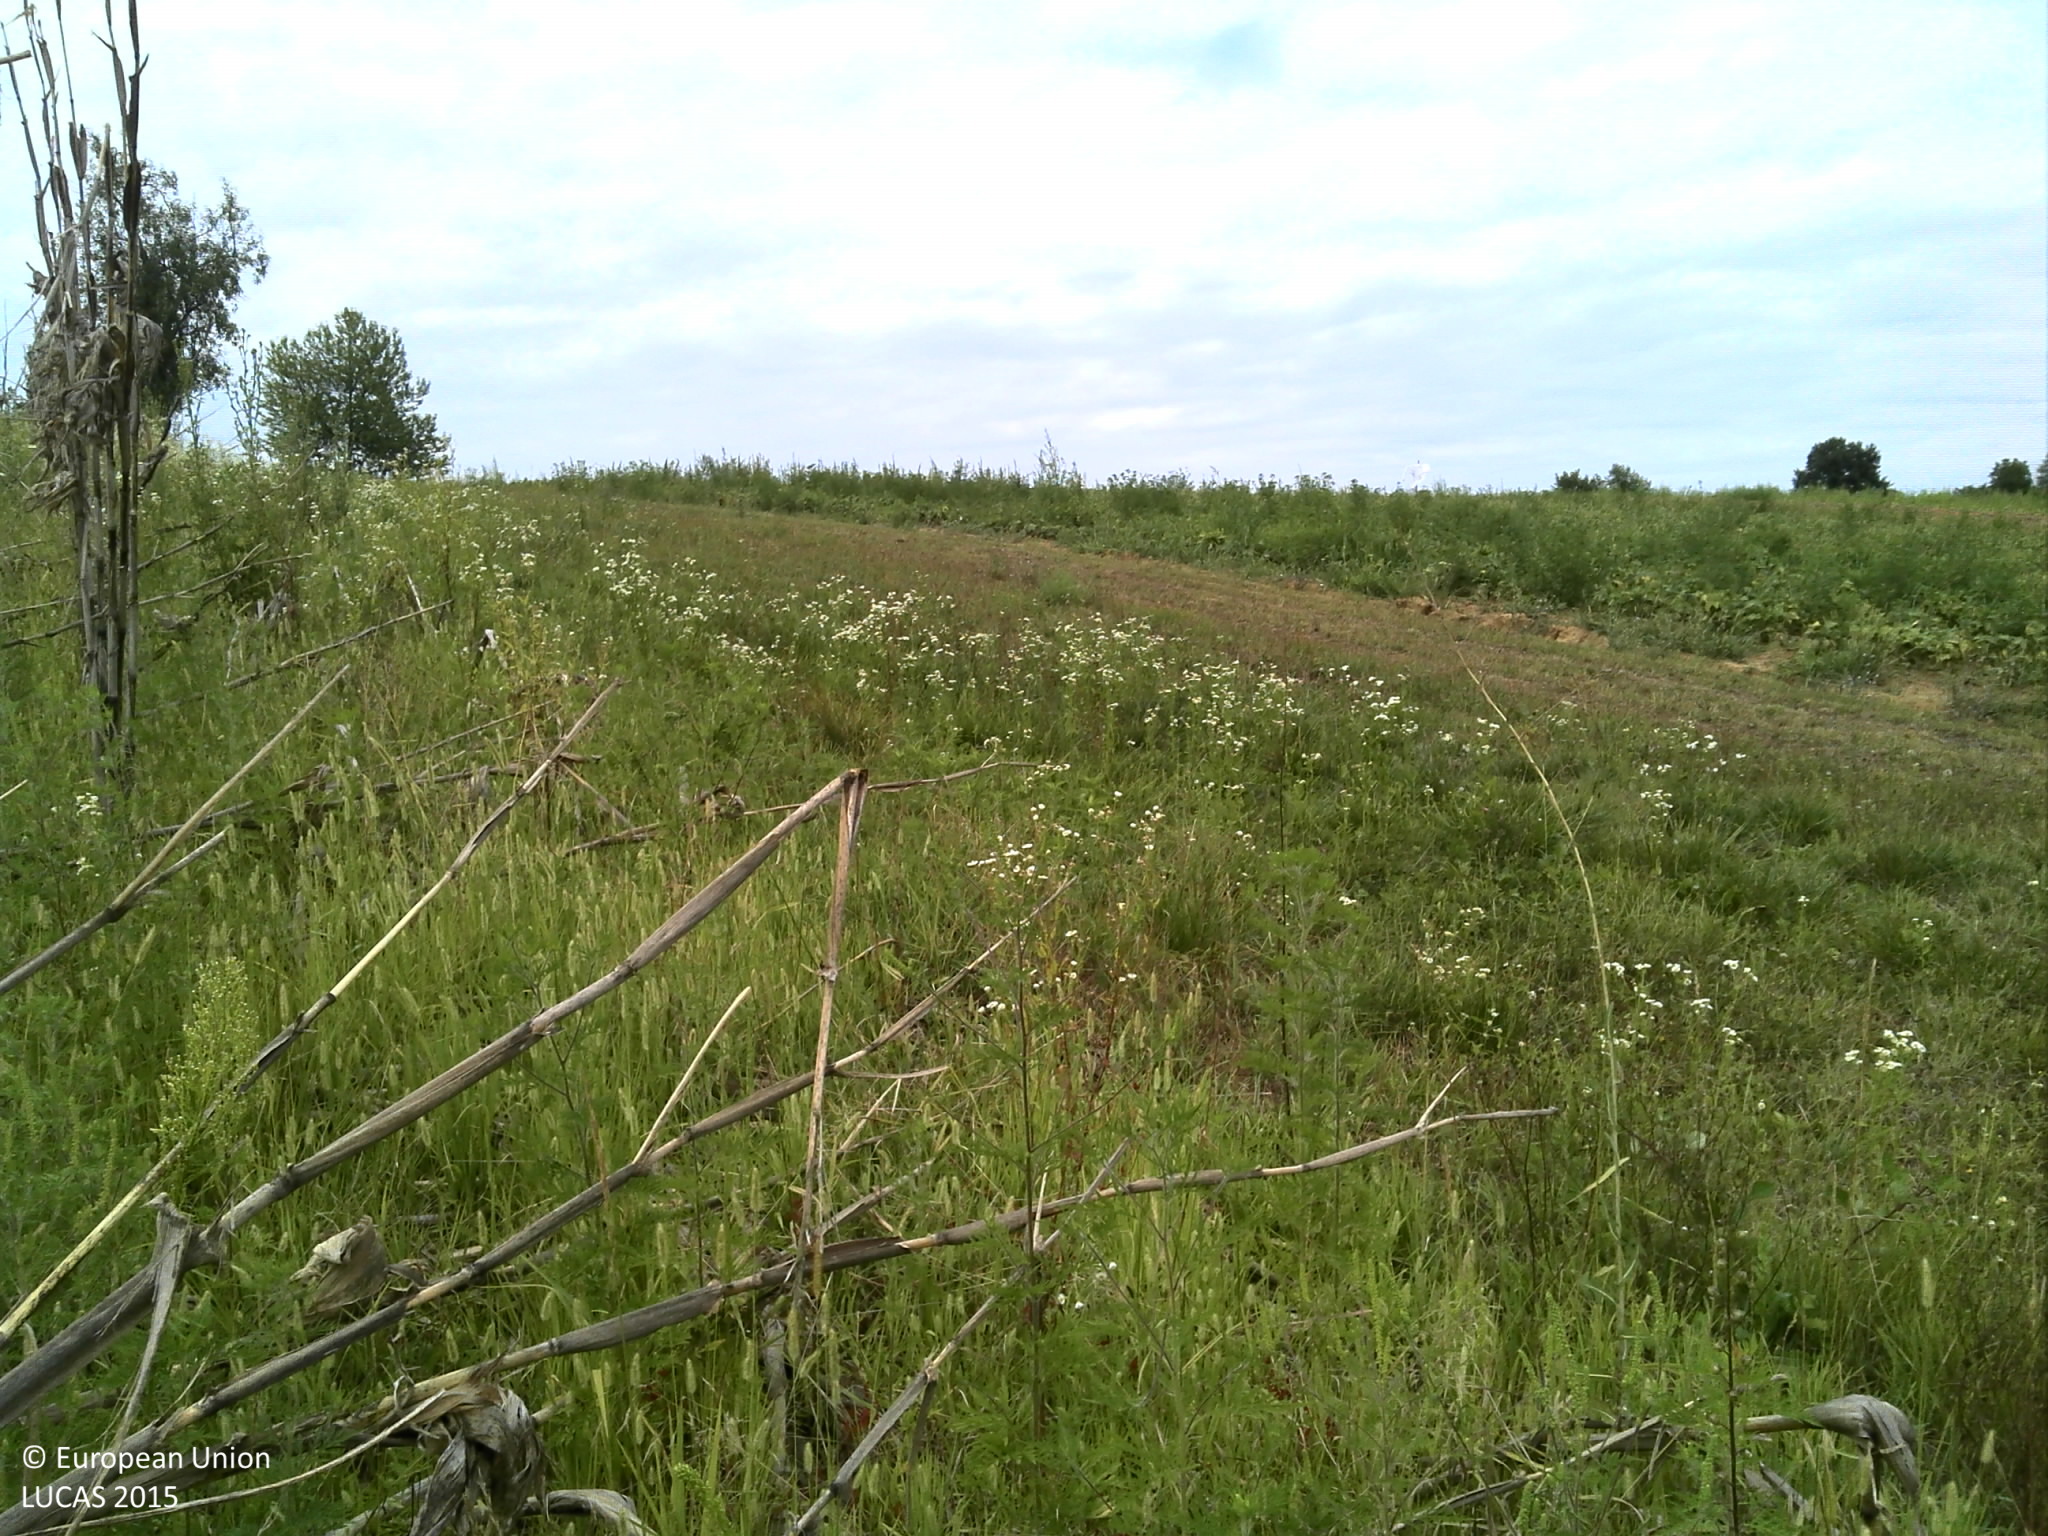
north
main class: Grassland
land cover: Spontaneously vegetated surfaces
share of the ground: > 75 %
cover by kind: herbaceous plants 100 %
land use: Semi-natural and natural areas not in use
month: July
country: HR
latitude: 45.6034
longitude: 16.6274
